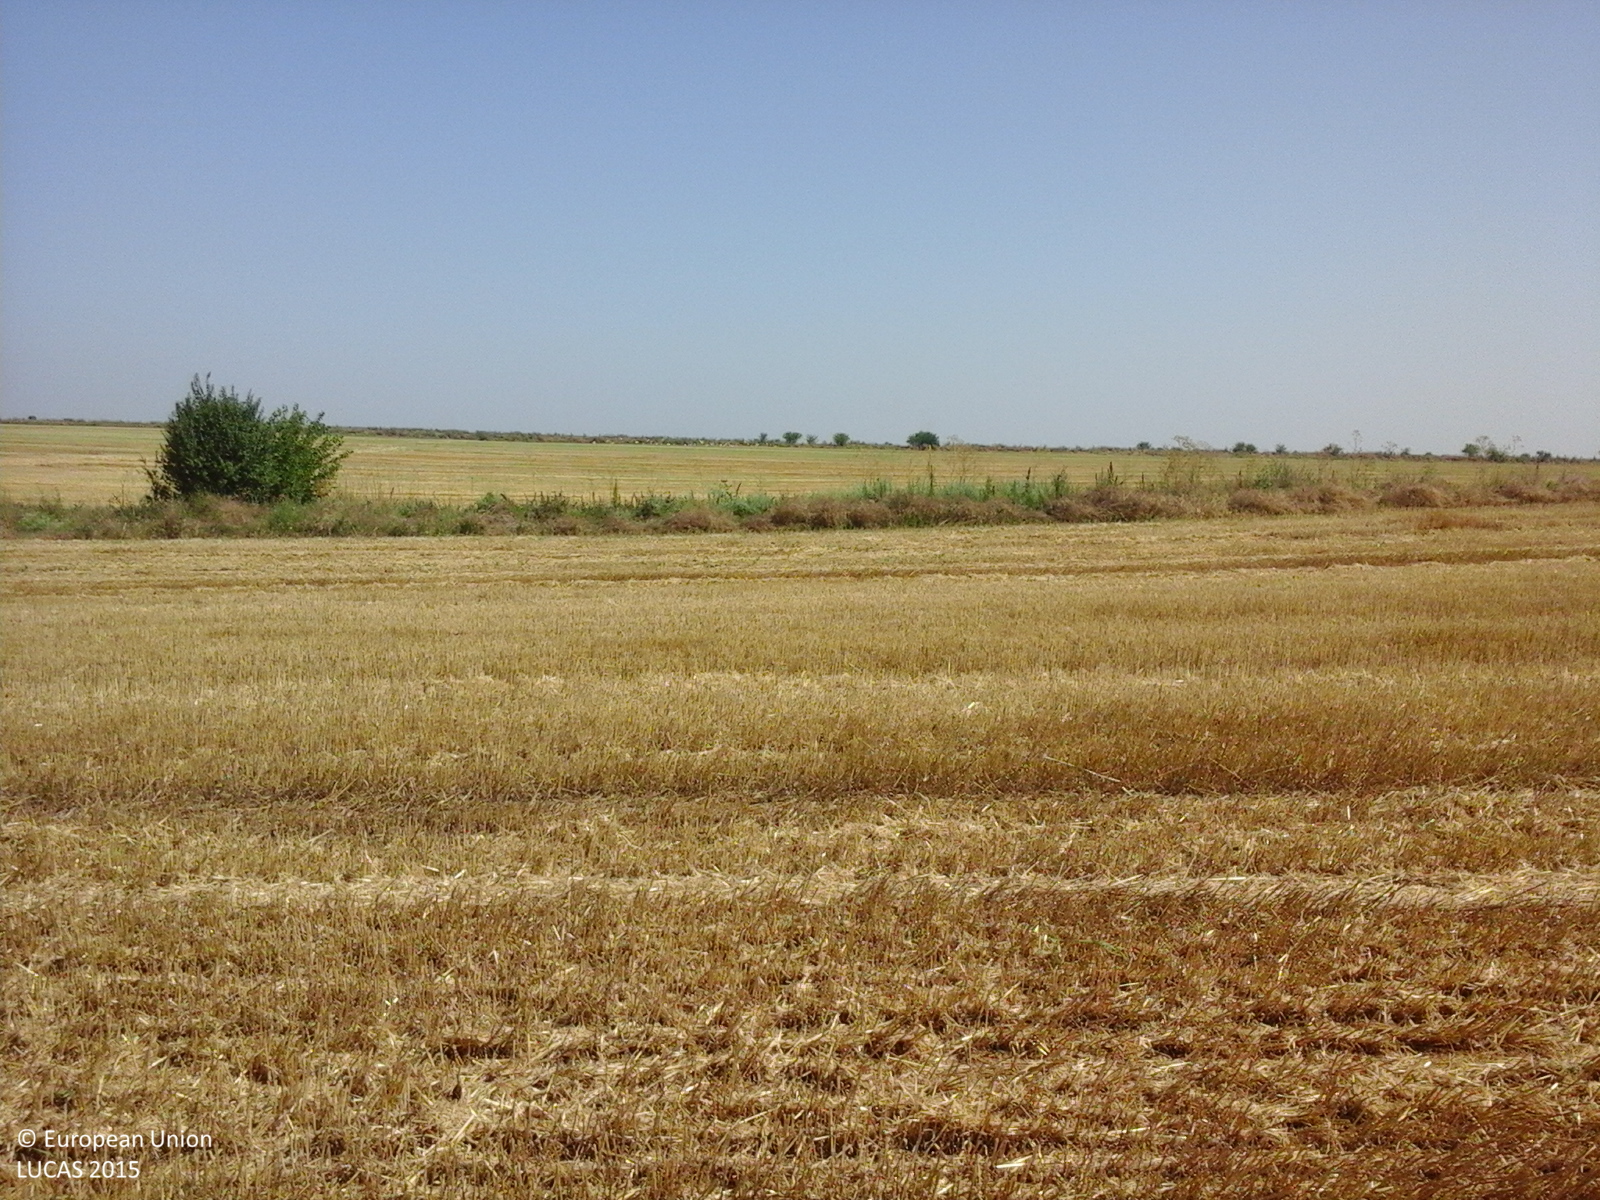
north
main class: Cropland
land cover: Durum wheat
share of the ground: > 75 %
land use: Agriculture (excluding fallow land and kitchen gardens)
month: July
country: RO
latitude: 44.2868
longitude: 27.4964
